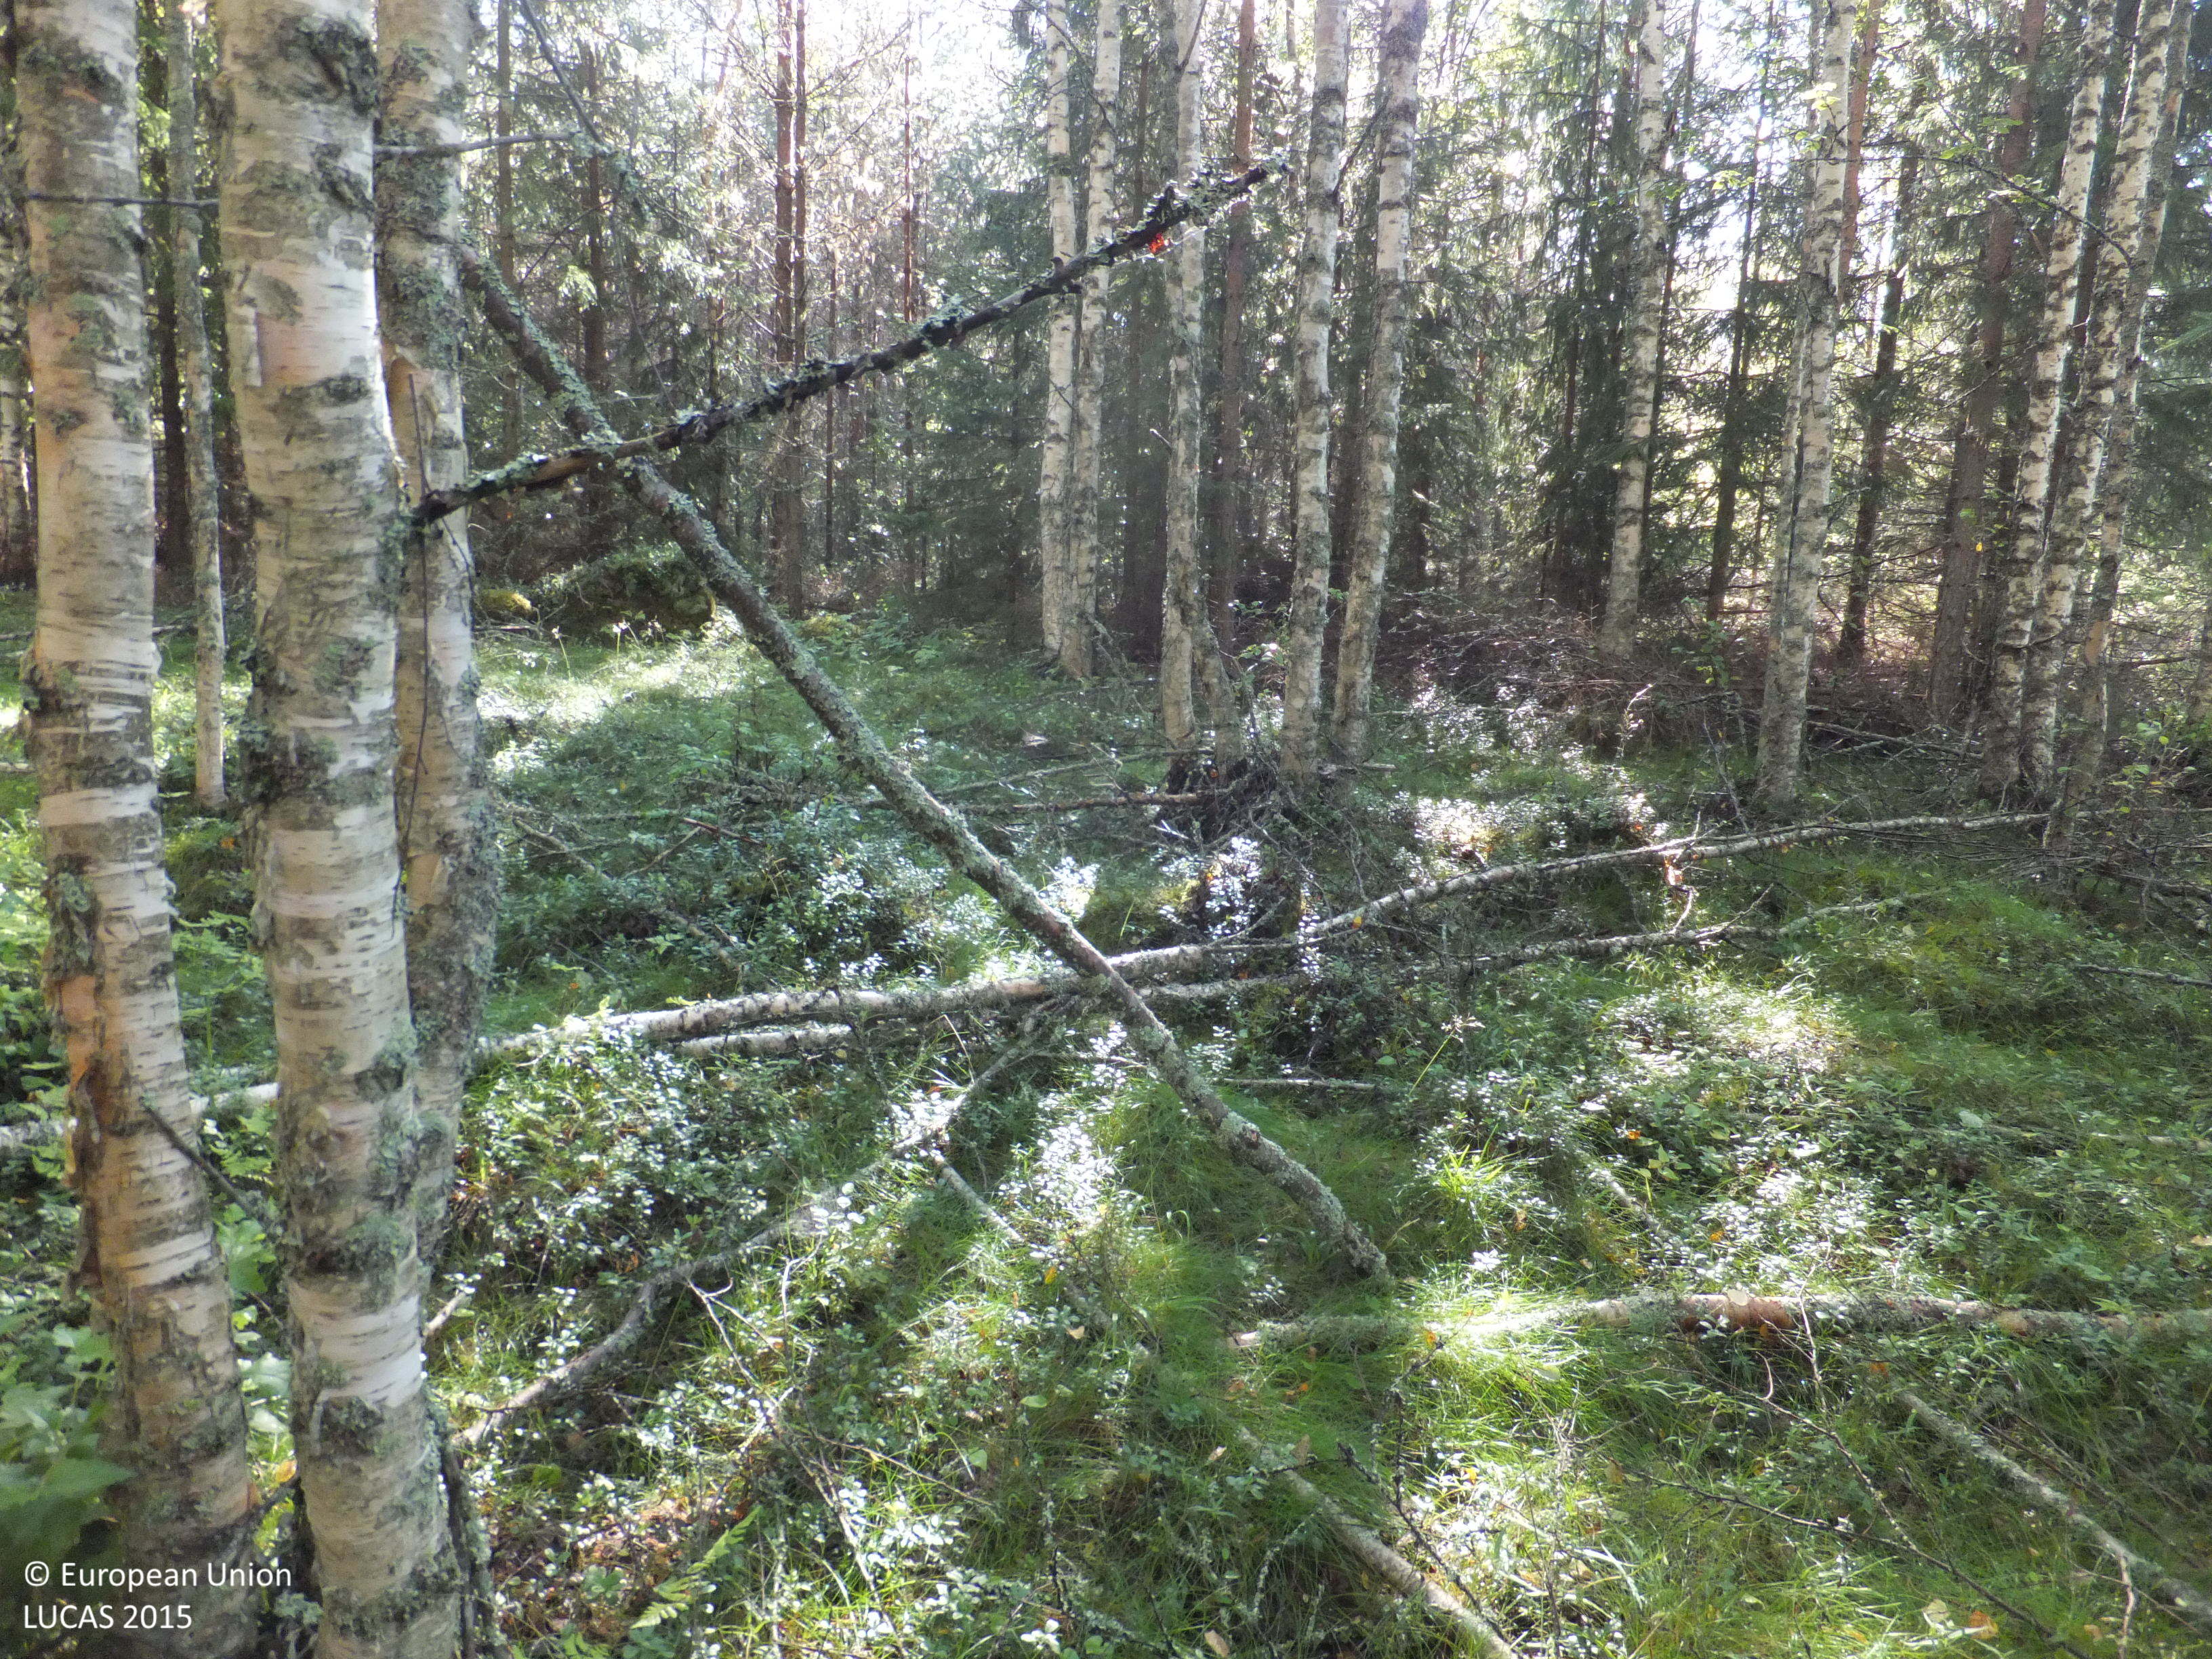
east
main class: Woodland
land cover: Broadleaved woodland
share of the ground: 50 - 75 %
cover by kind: broadleaved forest trees 60 %, shrubs 15 %, herbaceous plants 10 %, lichens and mosses 10 %, coniferous forest trees 5 %
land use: Forestry
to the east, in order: Broadleaved woodland; Spruce dominated mixed woodland; Pine dominated coniferous woodland; Spruce dominated mixed woodland; Ditches and canals; Spruce dominated mixed woodland; Other mixed woodland; Ditches and canals; Other mixed woodland; Ditches and canals; Pine dominated coniferous woodland; Ditches and canals; Pine dominated coniferous woodland; Other mixed woodland; Ditches and canals; Other mixed woodland
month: August
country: FI
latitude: 63.1503
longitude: 22.0512
